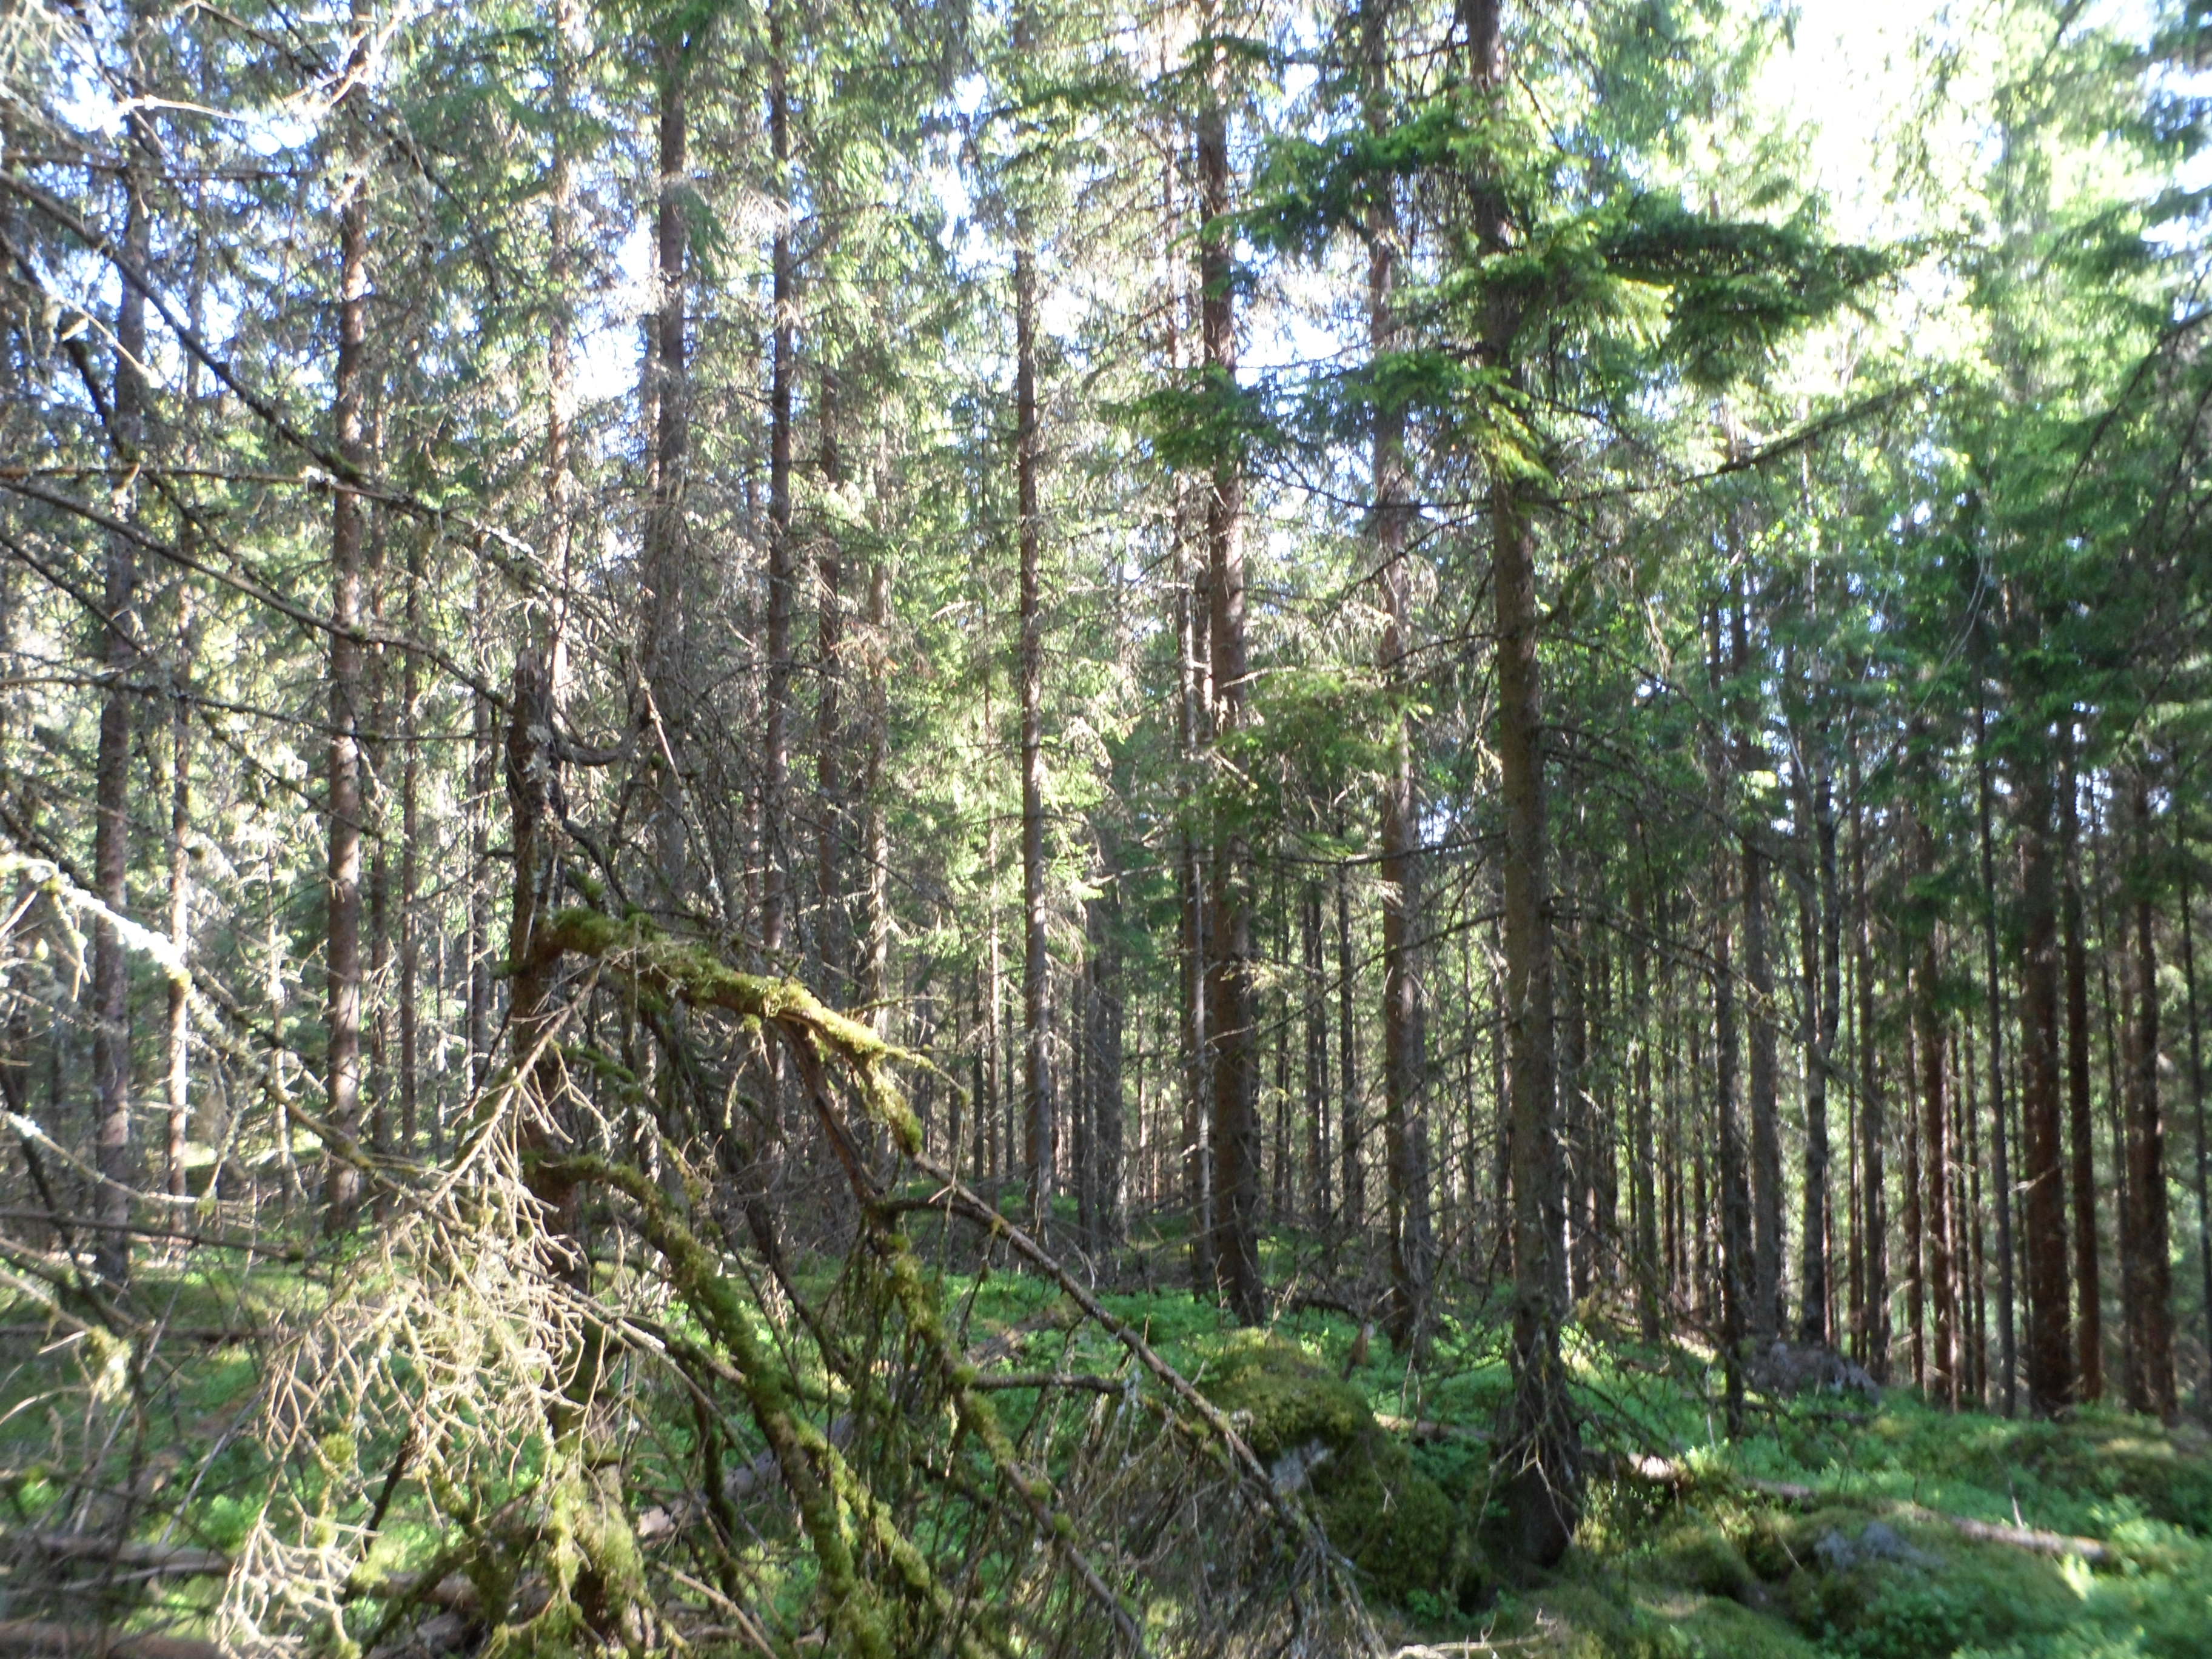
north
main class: Woodland
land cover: Spruce dominated coniferous woodland
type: boreal forest
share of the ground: 50 - 75 %
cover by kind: coniferous forest trees 70 %, lichens and mosses 15 %, shrubs 10 %, herbaceous plants 5 %
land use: Forestry
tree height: > 5 m
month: June
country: SE
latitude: 57.4603
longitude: 13.9128
